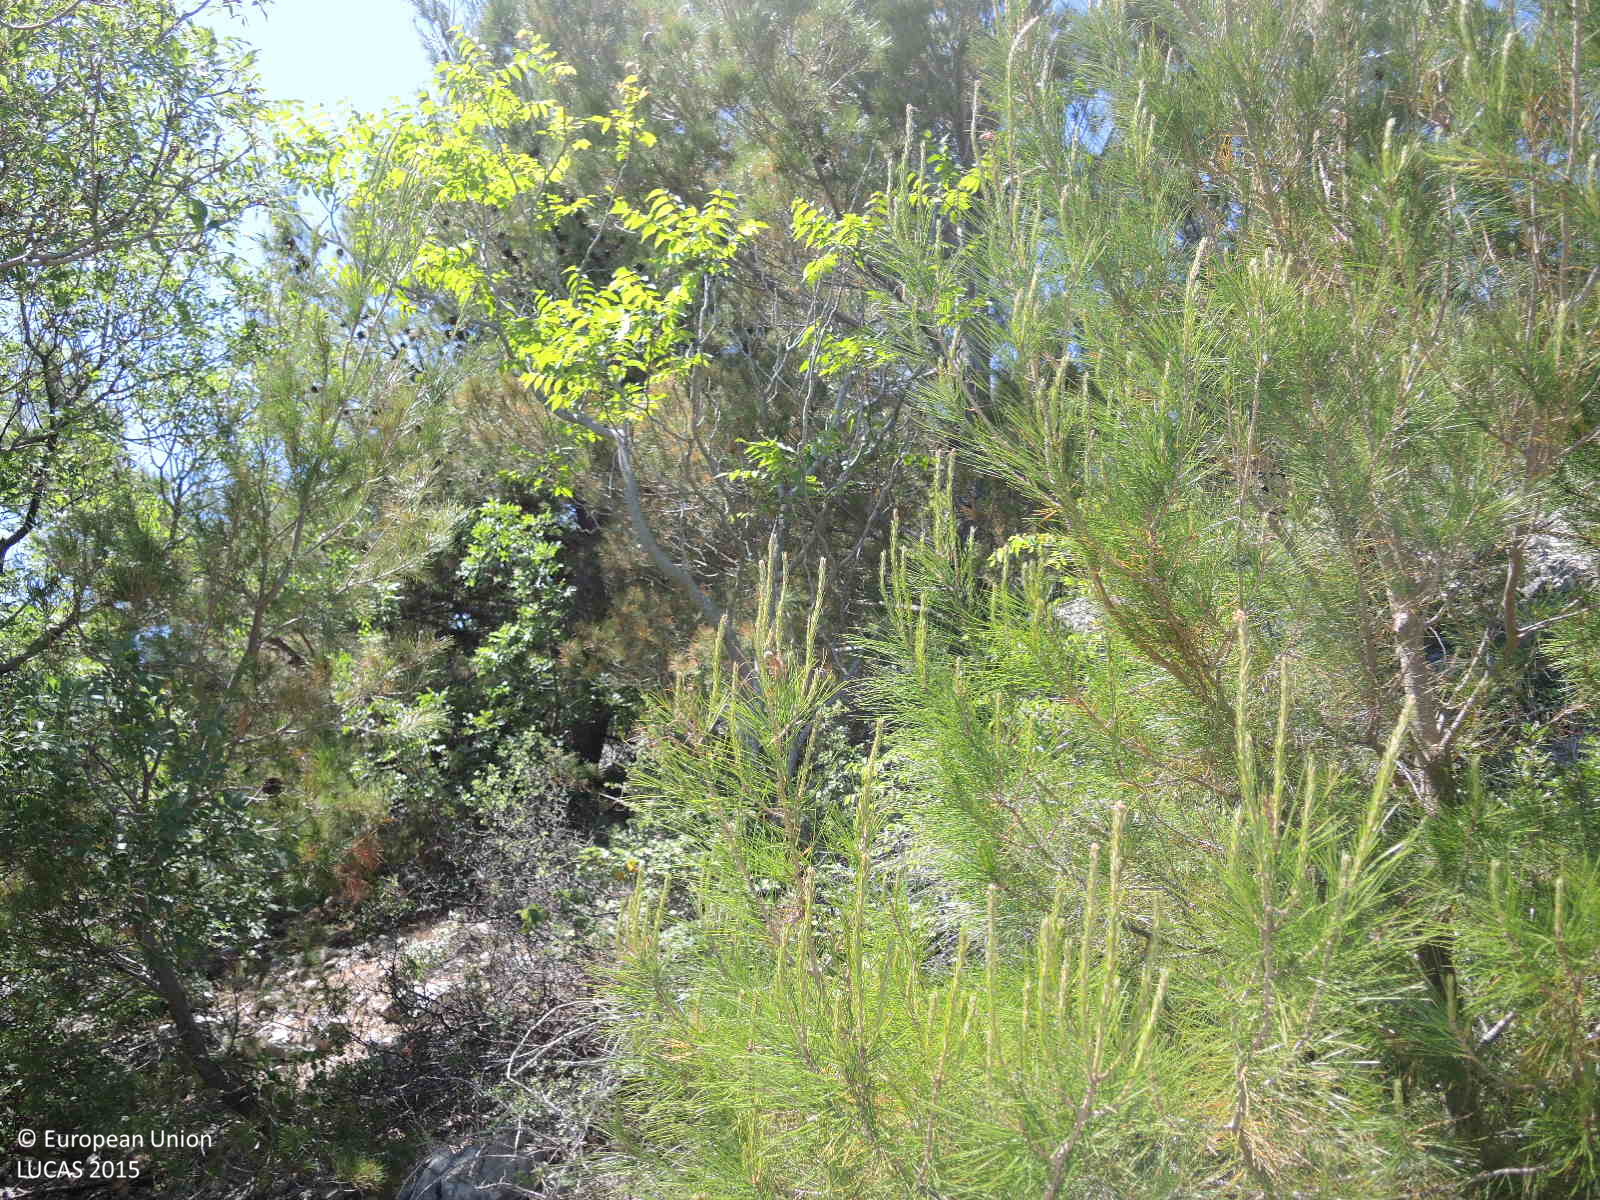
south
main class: Woodland
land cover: Pine dominated coniferous woodland
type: coniferous forest of the mediterranean region
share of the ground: 10 - 25 %
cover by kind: unconsolidated bare surface 65 %, coniferous forest trees 20 %, consolidated bare surface 10 %, shrubs 5 %
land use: Semi-natural and natural areas not in use
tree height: > 5 m
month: May
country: HR
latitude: 43.8349
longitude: 15.9734
